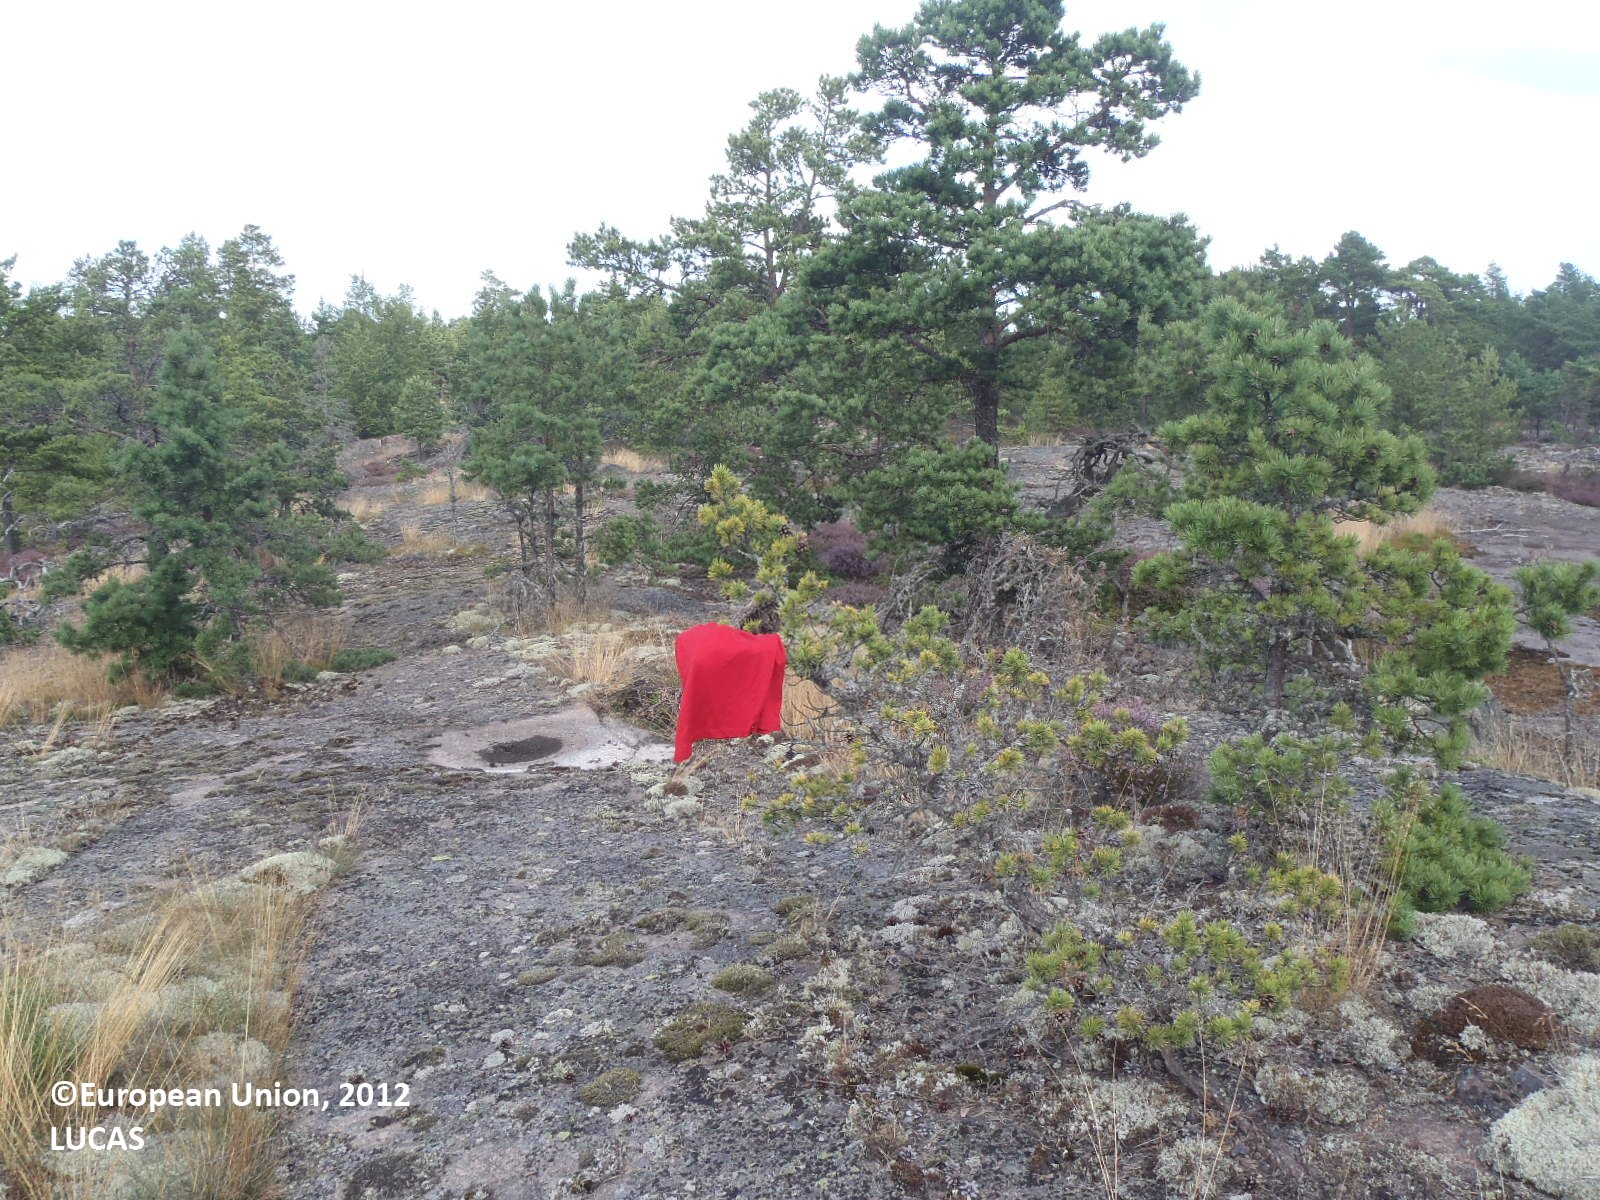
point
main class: Woodland
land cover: Pine dominated coniferous woodland
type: boreal forest
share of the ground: 10 - 25 %
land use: Semi-natural and natural areas not in use
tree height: > 5 m
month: August
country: FI
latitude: 60.3467
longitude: 20.3191
